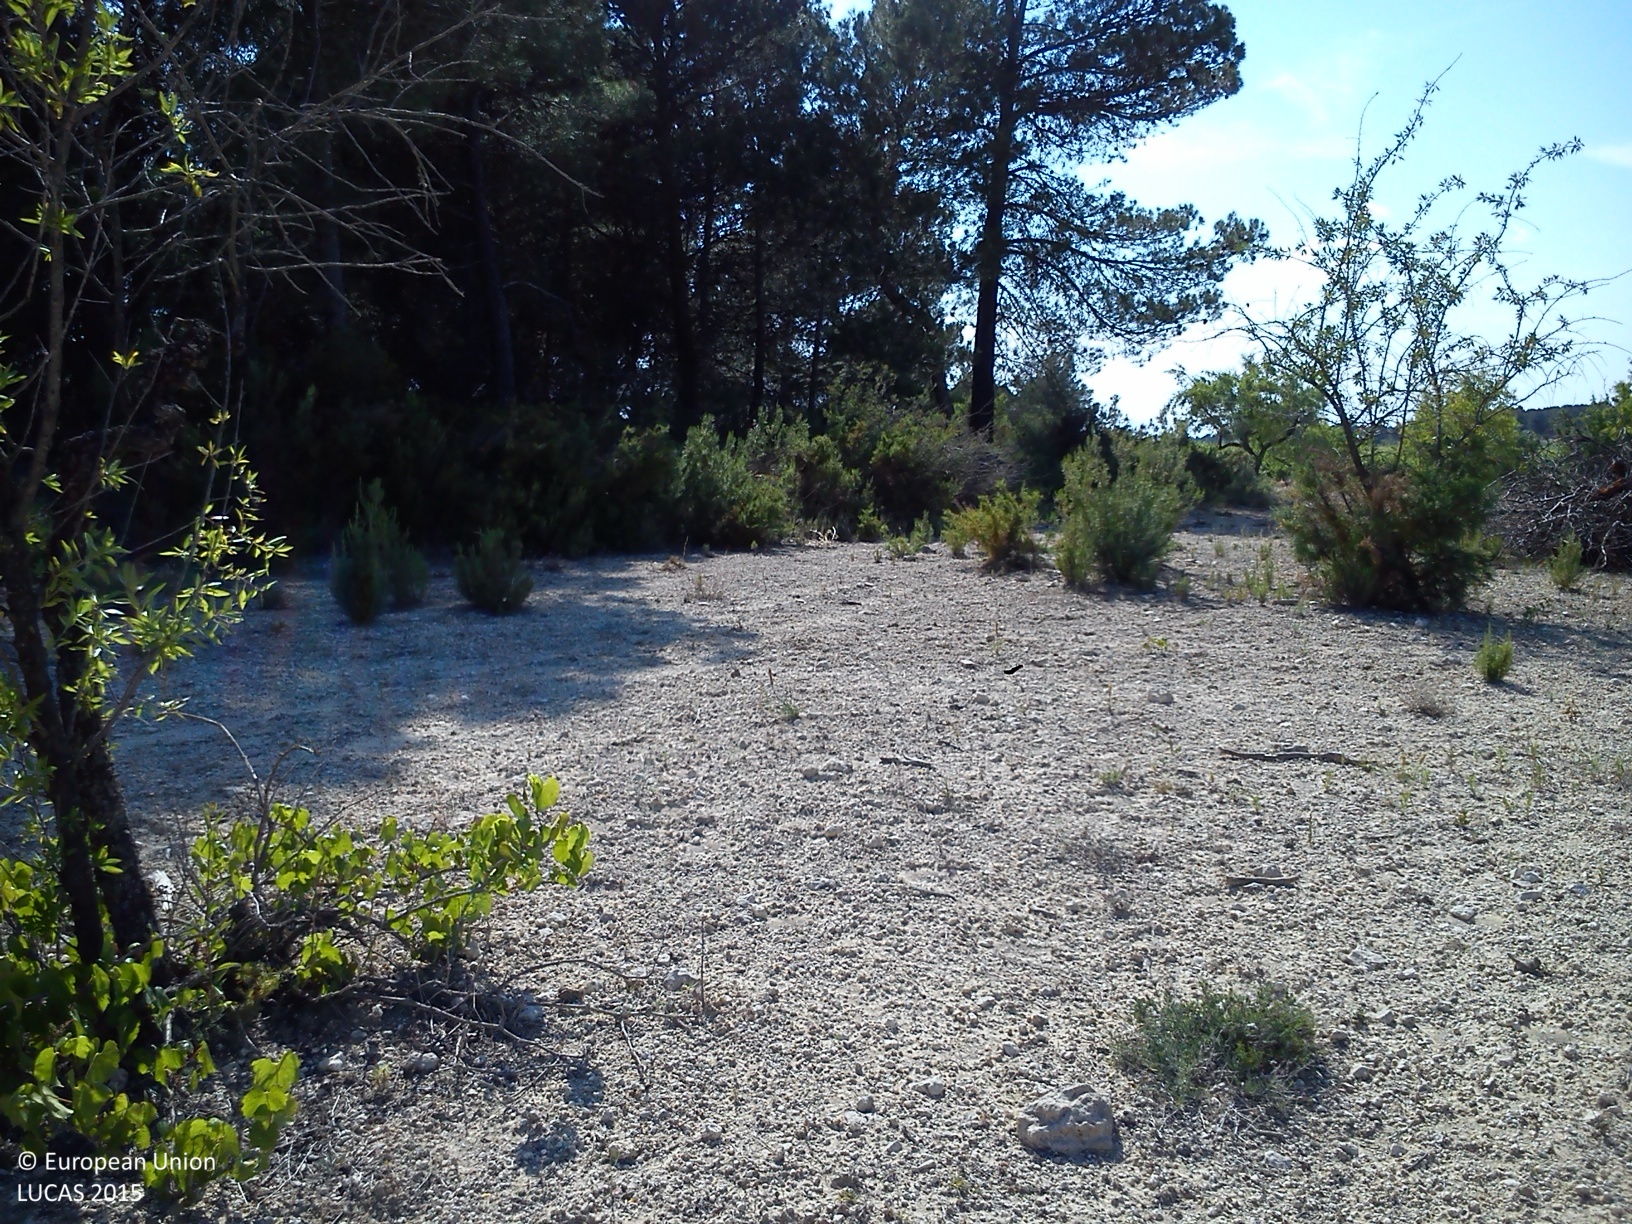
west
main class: Shrubland
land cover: Shrubland with sparse tree cover
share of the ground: 10 - 25 %
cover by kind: herbaceous plants 40 %, unconsolidated bare surface 35 %, shrubs 20 %, coniferous forest trees 5 %
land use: Abandoned areas
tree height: < 5 m
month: June
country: ES
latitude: 39.3098
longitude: -1.0746
